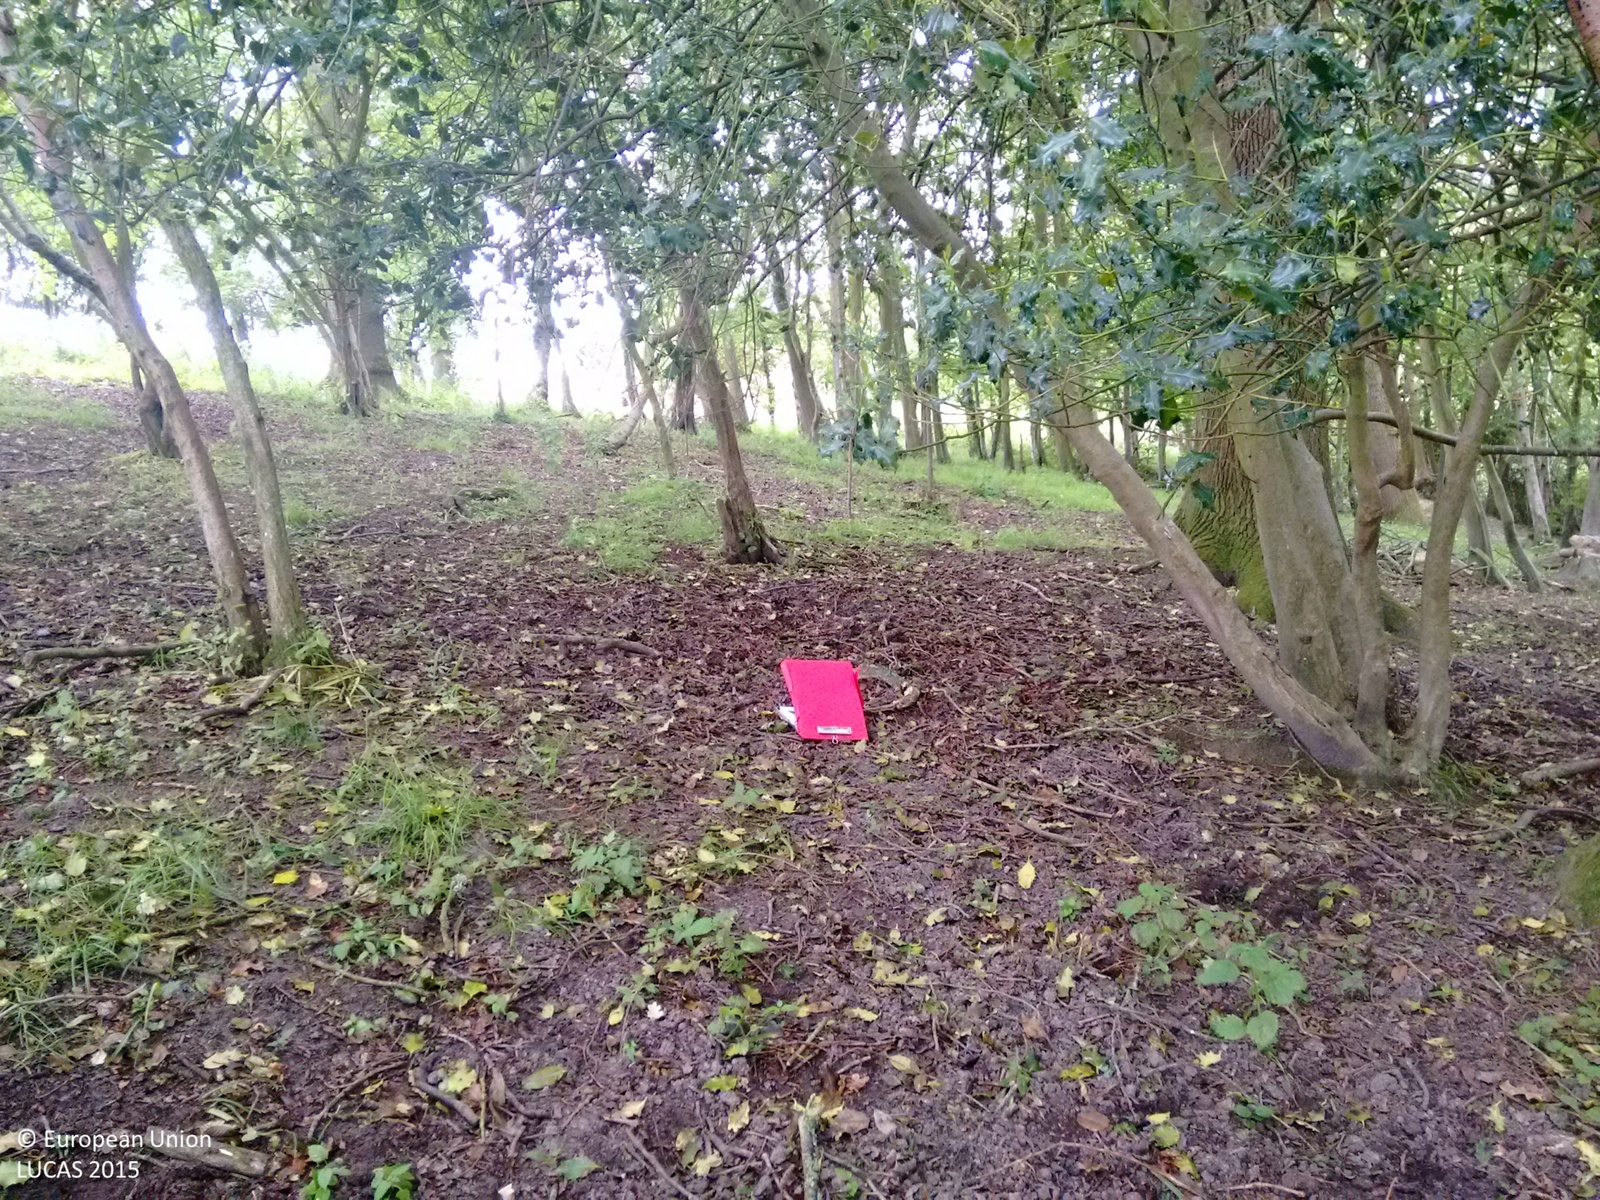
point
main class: Woodland
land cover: Broadleaved woodland
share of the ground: > 75 %
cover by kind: broadleaved forest trees 90 %, shrubs 10 %
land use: Semi-natural and natural areas not in use
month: June
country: GB
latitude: 50.9523
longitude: 0.3622
